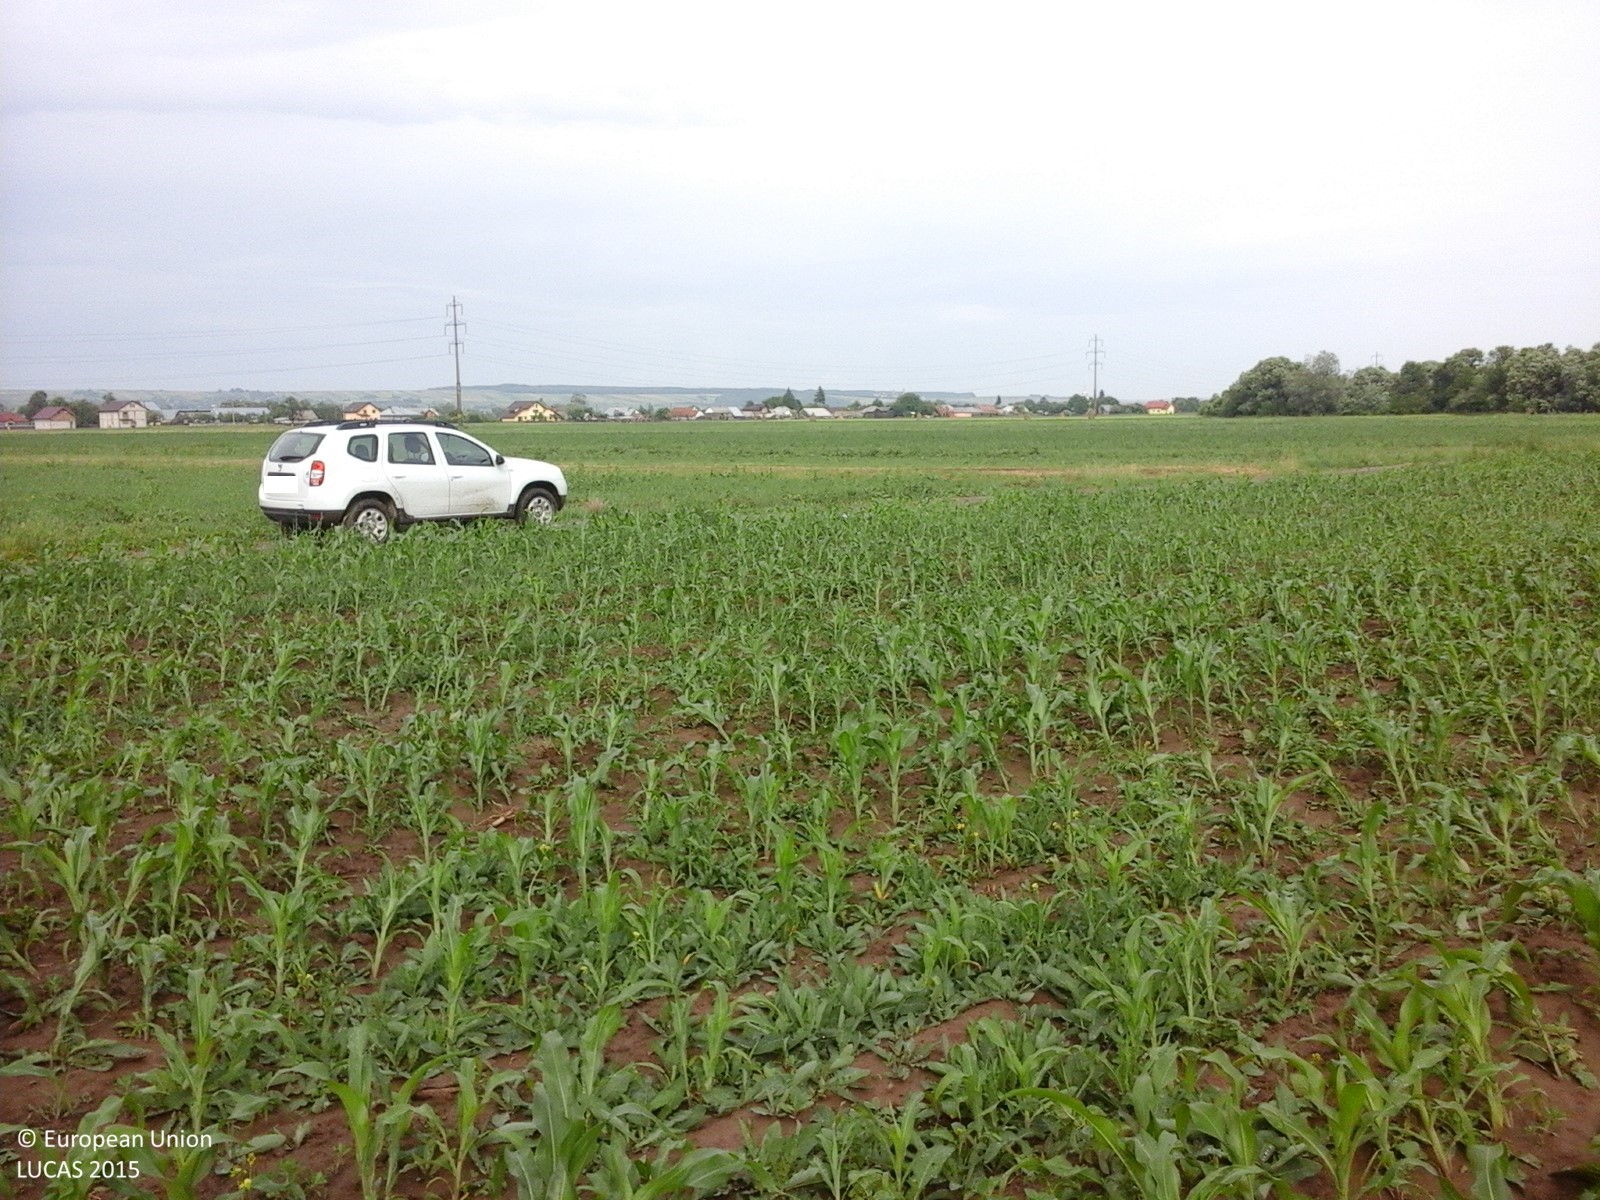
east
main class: Cropland
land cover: Maize
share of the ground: 50 - 75 %
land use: Agriculture (excluding fallow land and kitchen gardens)
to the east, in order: Maize; Grass margins; Tracks; Grass margins; Lucerne; Maize; Grass margins; Tracks; Grass margins; Oats; Lucerne; Spontaneously vegetated surfaces; Maize
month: June
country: RO
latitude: 47.3621
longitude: 26.3297
